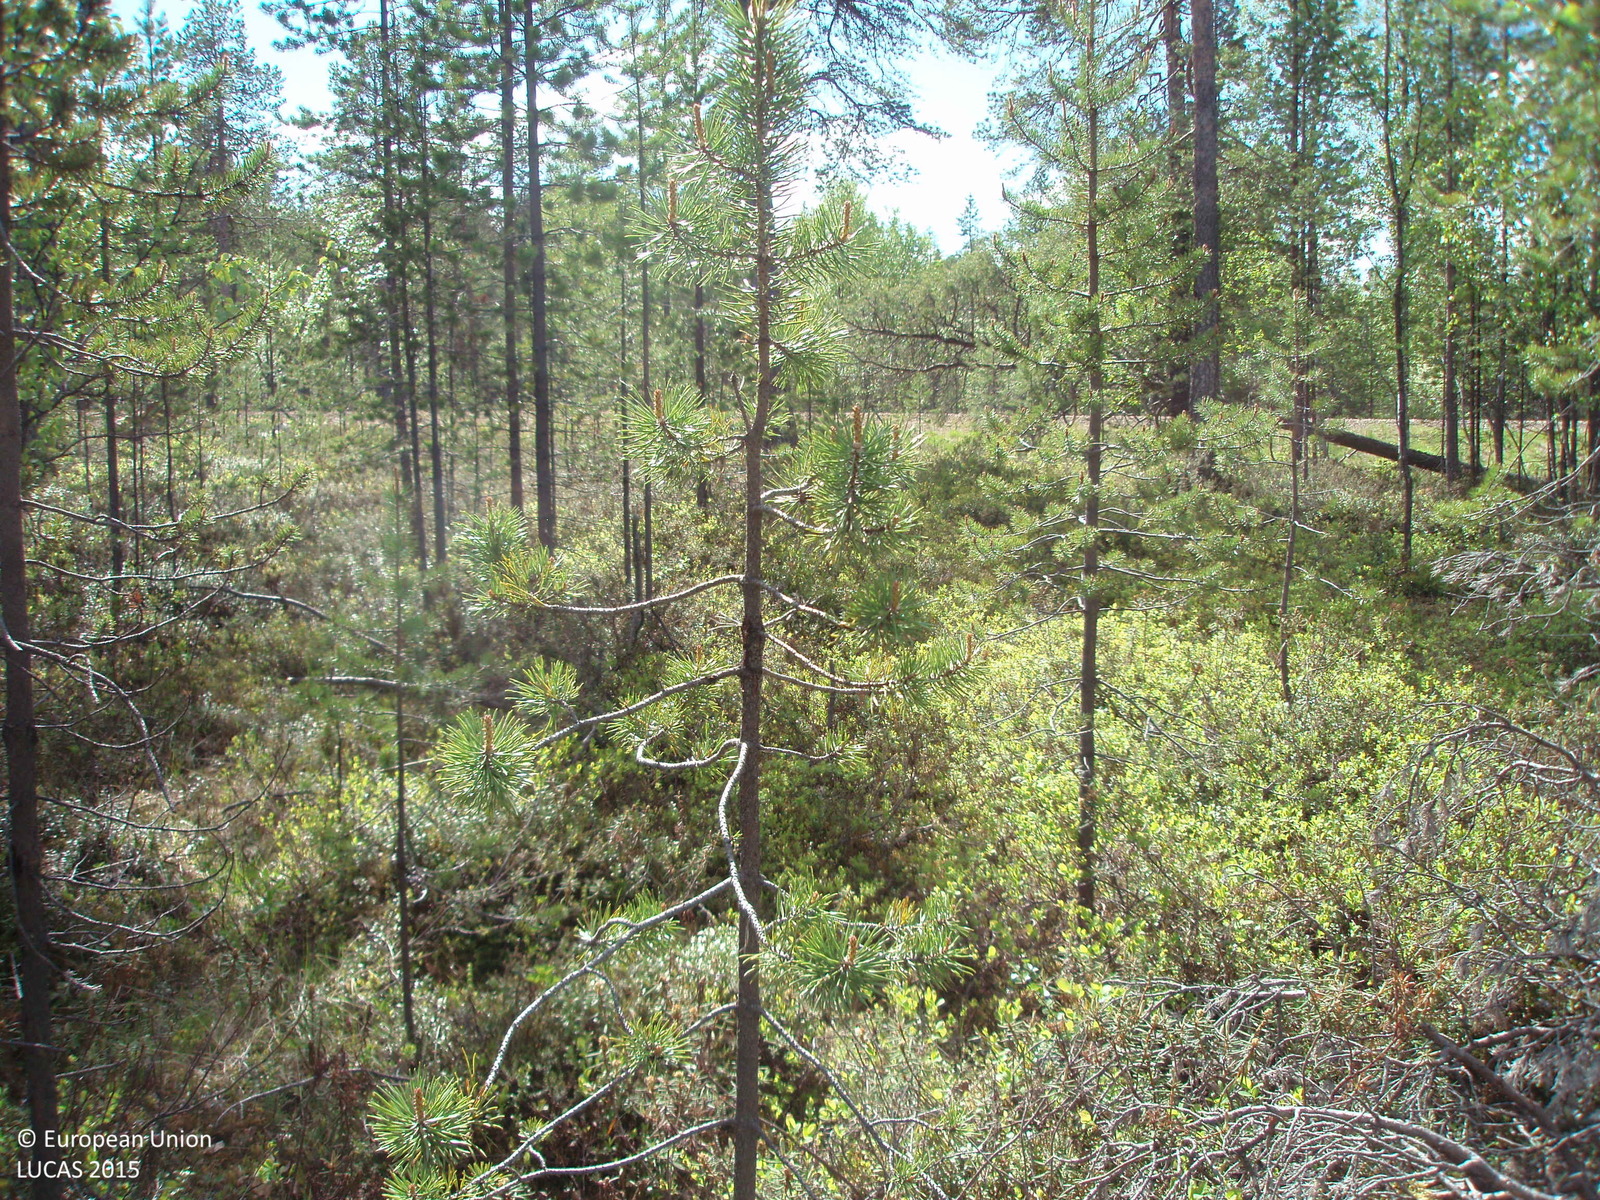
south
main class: Woodland
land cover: Pine dominated mixed woodland
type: boreal forest
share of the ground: 50 - 75 %
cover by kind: broadleaved forest trees 40 %, coniferous forest trees 30 %, shrubs 20 %, herbaceous plants 5 %, lichens and mosses 5 %
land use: Forestry
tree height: > 5 m
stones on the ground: 25 - 50 %
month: June
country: FI
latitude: 68.7707
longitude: 28.0821
